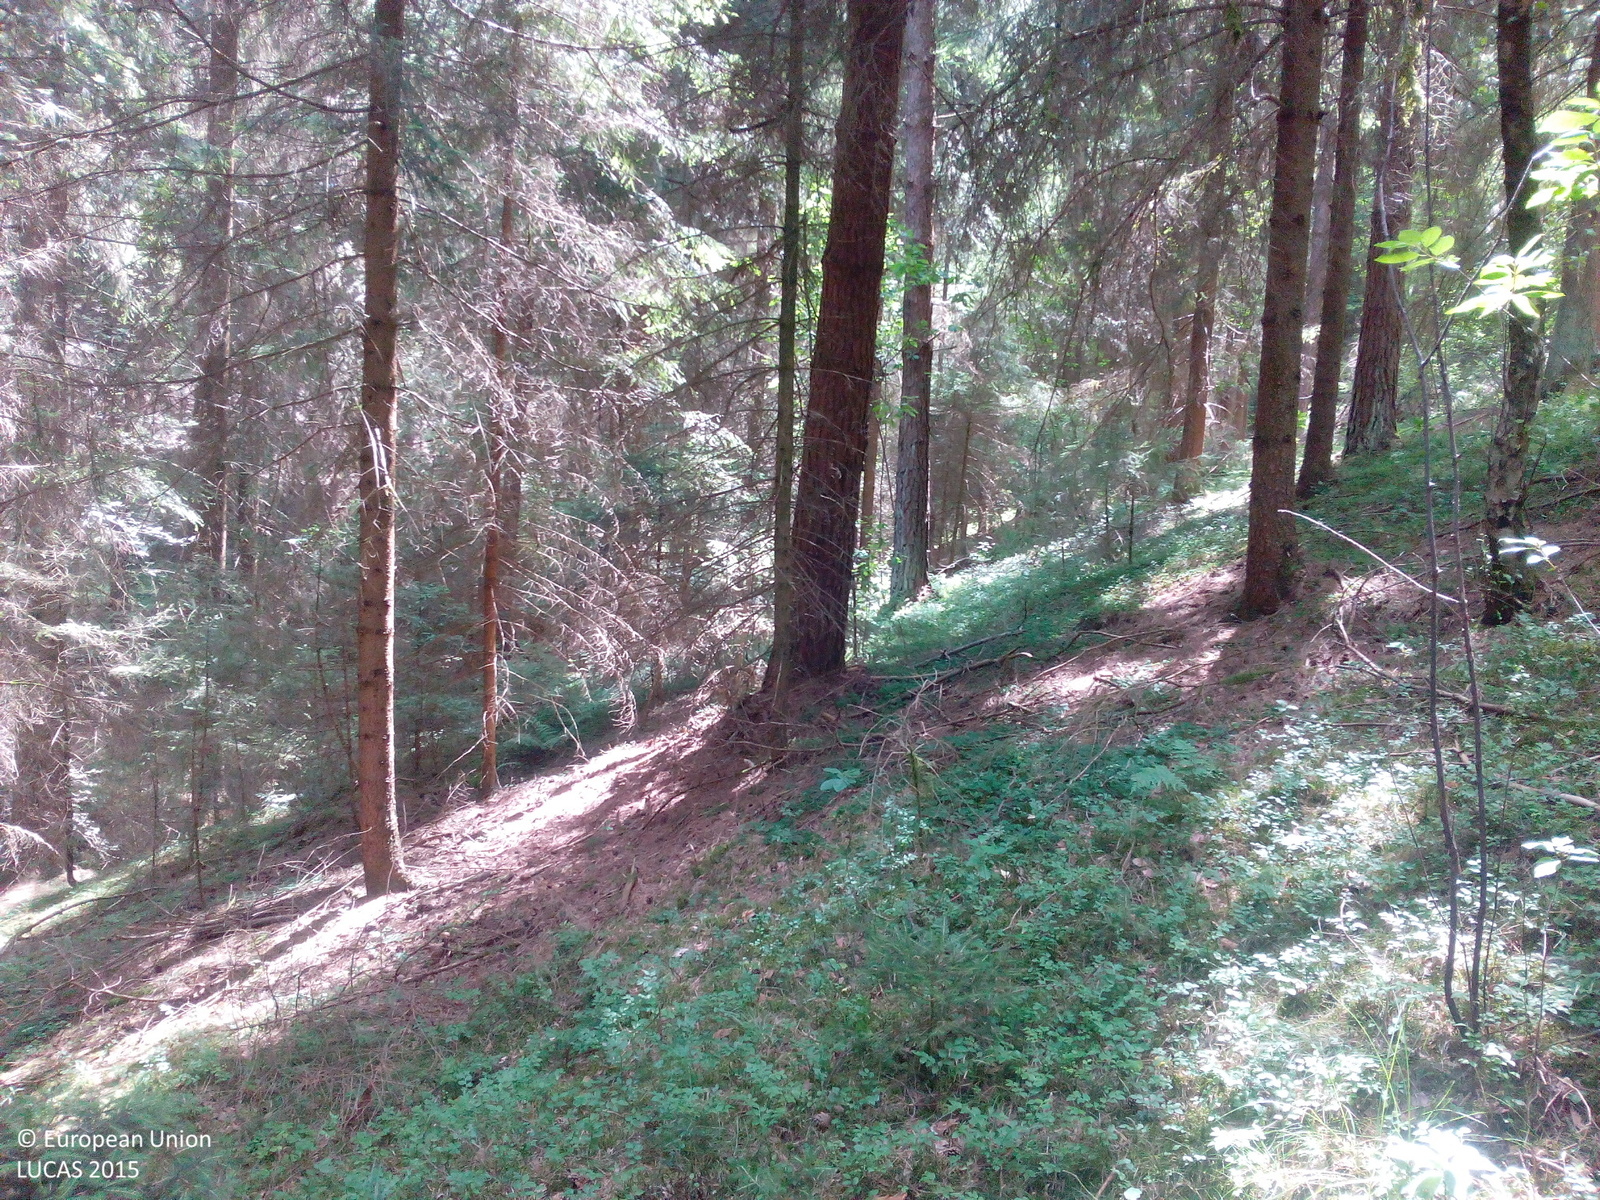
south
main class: Woodland
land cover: Spruce dominated coniferous woodland
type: hemiboreal forest and nemoral coniferous forest and mixed broadleaved-coniferous forest
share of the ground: > 75 %
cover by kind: coniferous forest trees 80 %, unconsolidated bare surface 10 %, shrubs 5 %, lichens and mosses 5 %
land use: Forestry
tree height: > 5 m
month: July
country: DE
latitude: 49.5868
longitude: 12.2266
